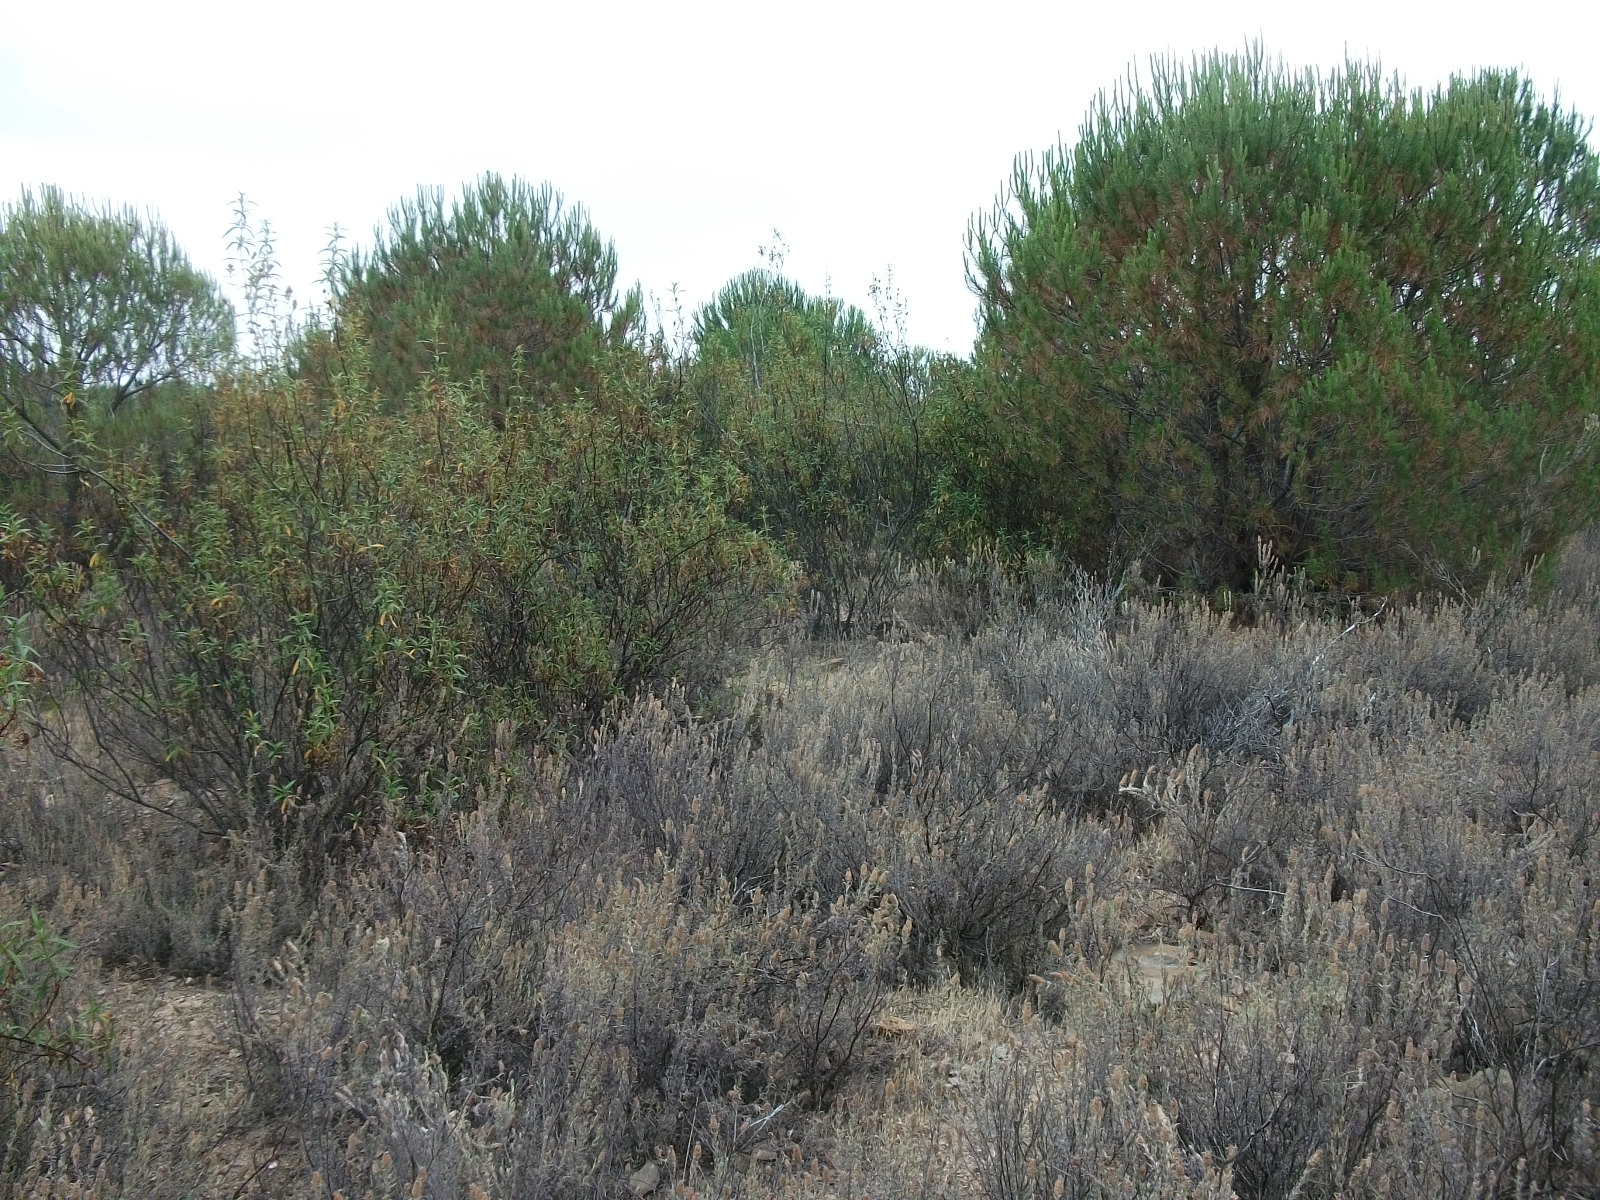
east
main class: Woodland
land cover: Pine dominated coniferous woodland
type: coniferous forest of the mediterranean region
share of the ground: 50 - 75 %
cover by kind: coniferous forest trees 60 %, shrubs 30 %, herbaceous plants 10 %
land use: Forestry
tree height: < 5 m
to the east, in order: Pine dominated coniferous woodland; Spontaneously vegetated surfaces; Pine dominated coniferous woodland; Tracks; Pine dominated coniferous woodland; Tracks; Pine dominated coniferous woodland
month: June
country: ES
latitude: 37.4610
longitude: -6.8981
